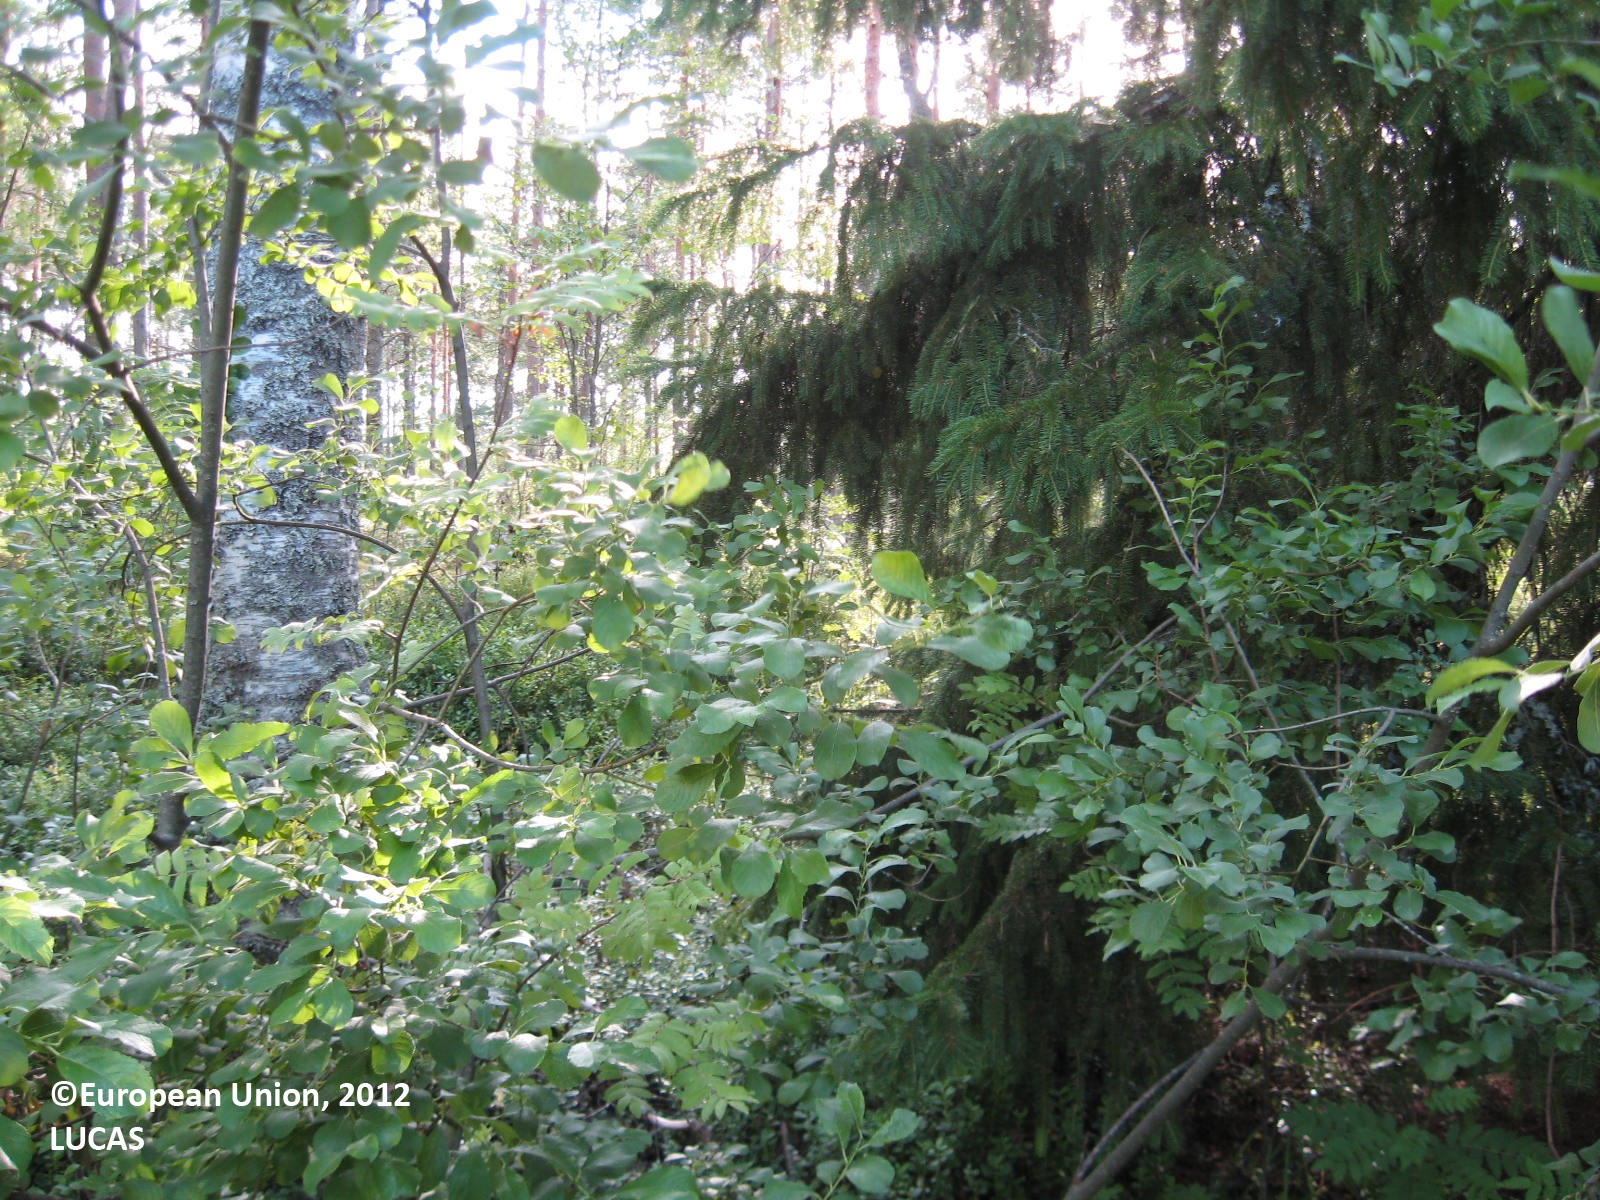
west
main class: Grassland
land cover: Grassland without tree/shrub cover
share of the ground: > 75 %
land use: Fallow land
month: July
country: FI
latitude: 62.0337
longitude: 21.6125
